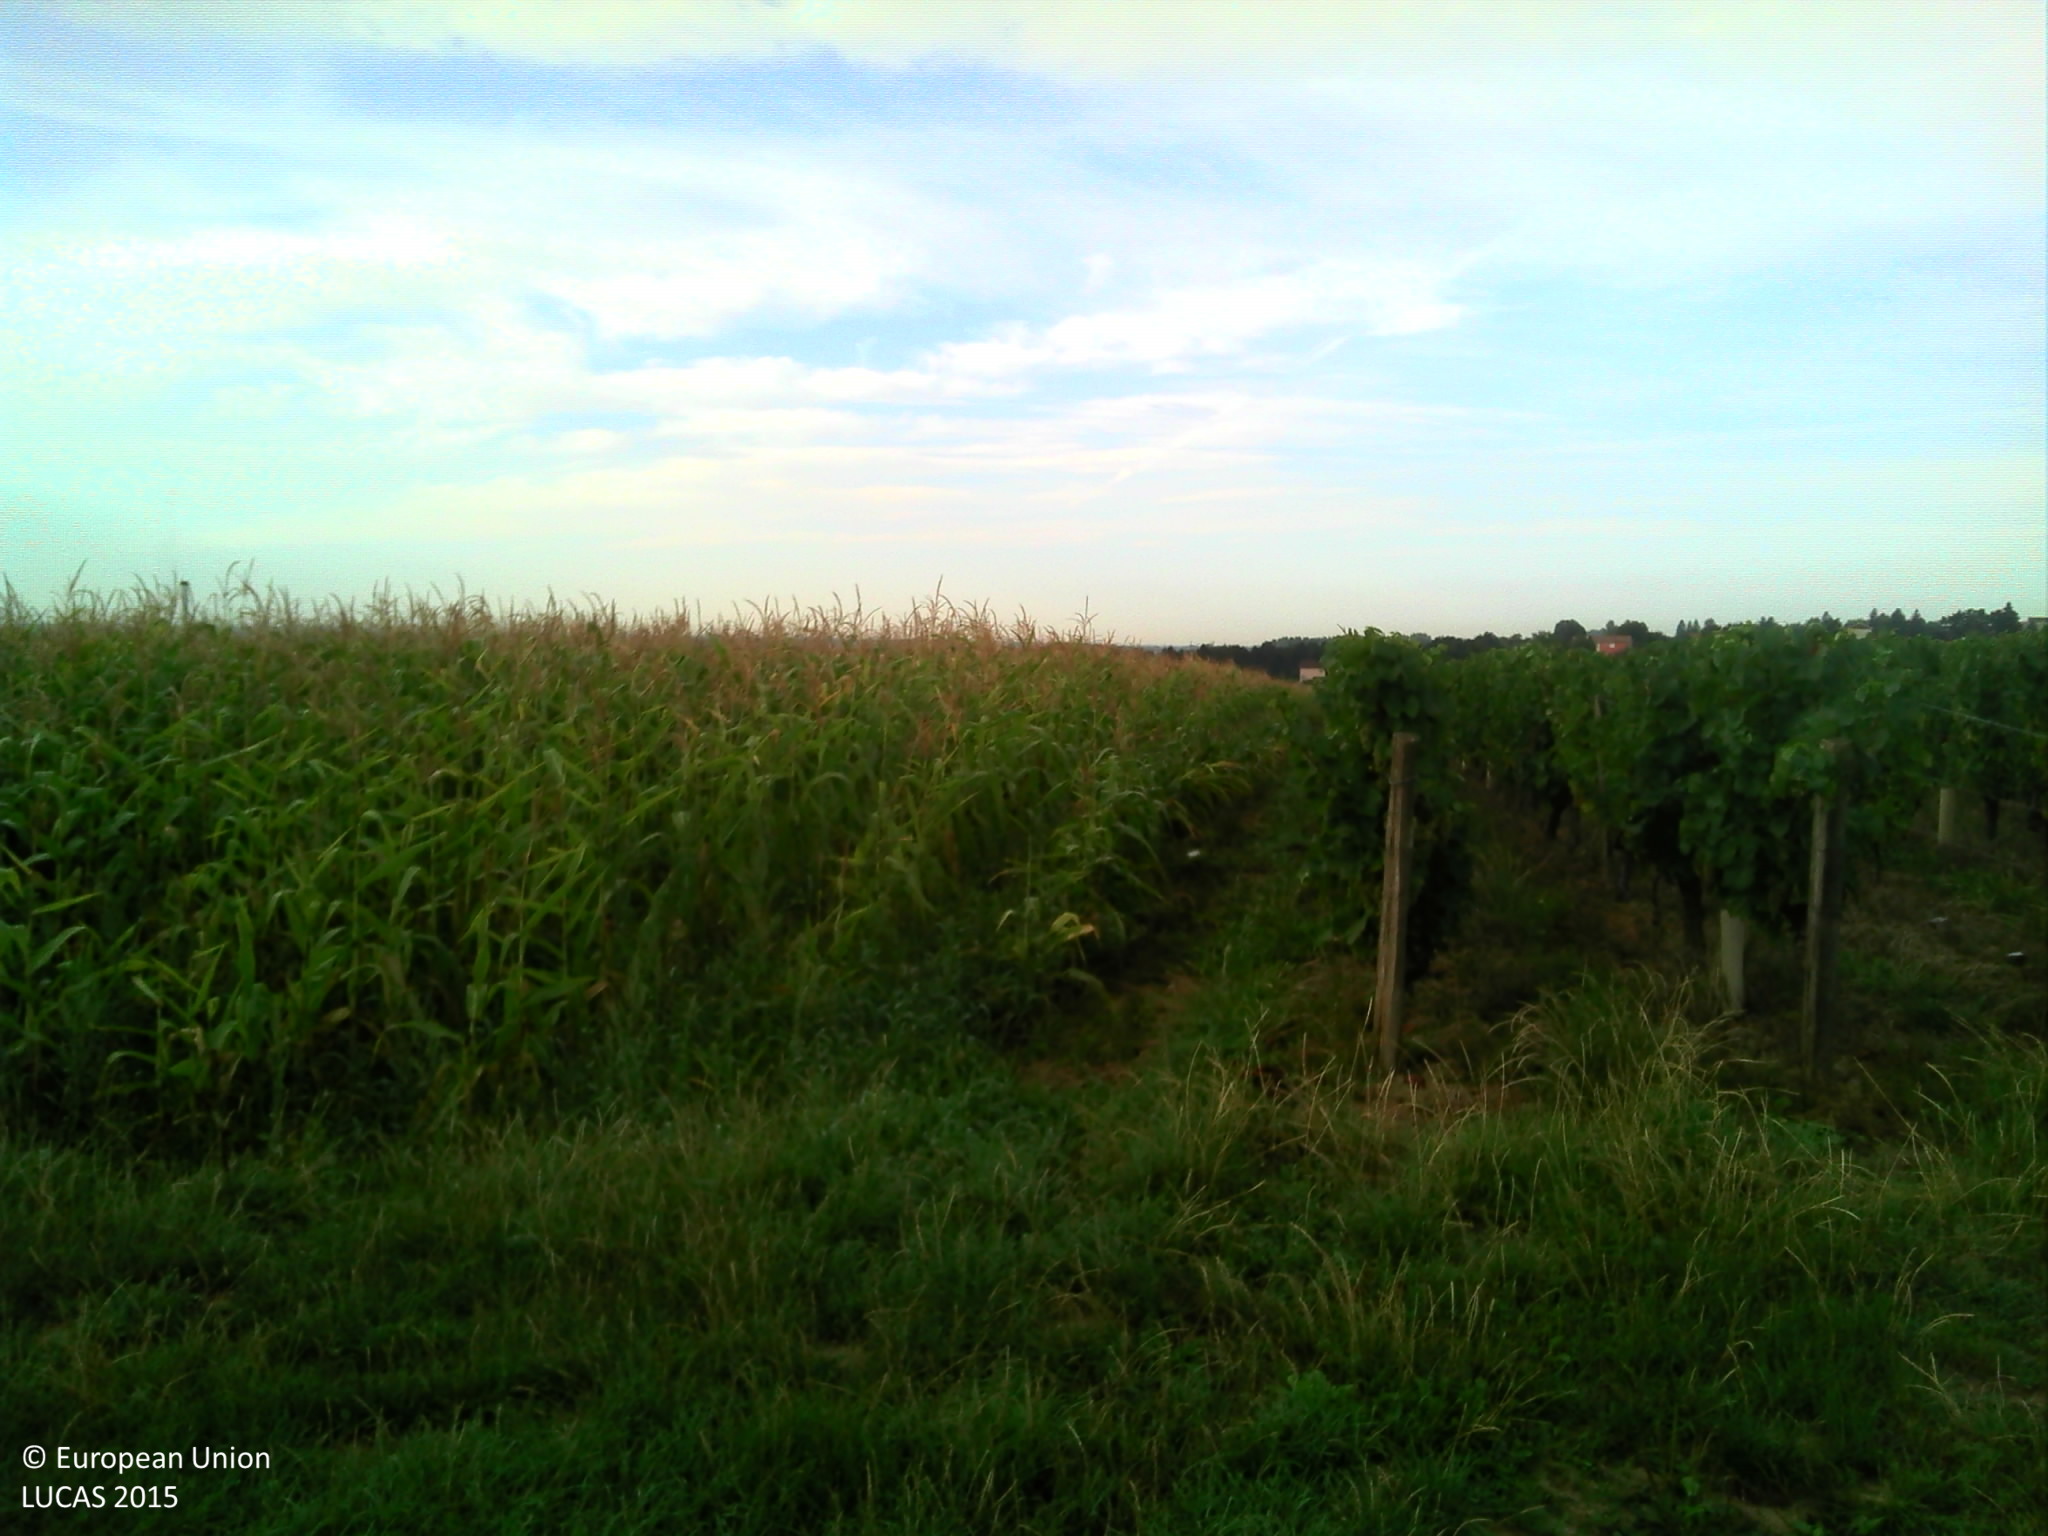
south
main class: Cropland
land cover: Maize
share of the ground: > 75 %
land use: Agriculture (excluding fallow land and kitchen gardens)
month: August
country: FR
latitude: 46.3903
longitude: 4.8655
